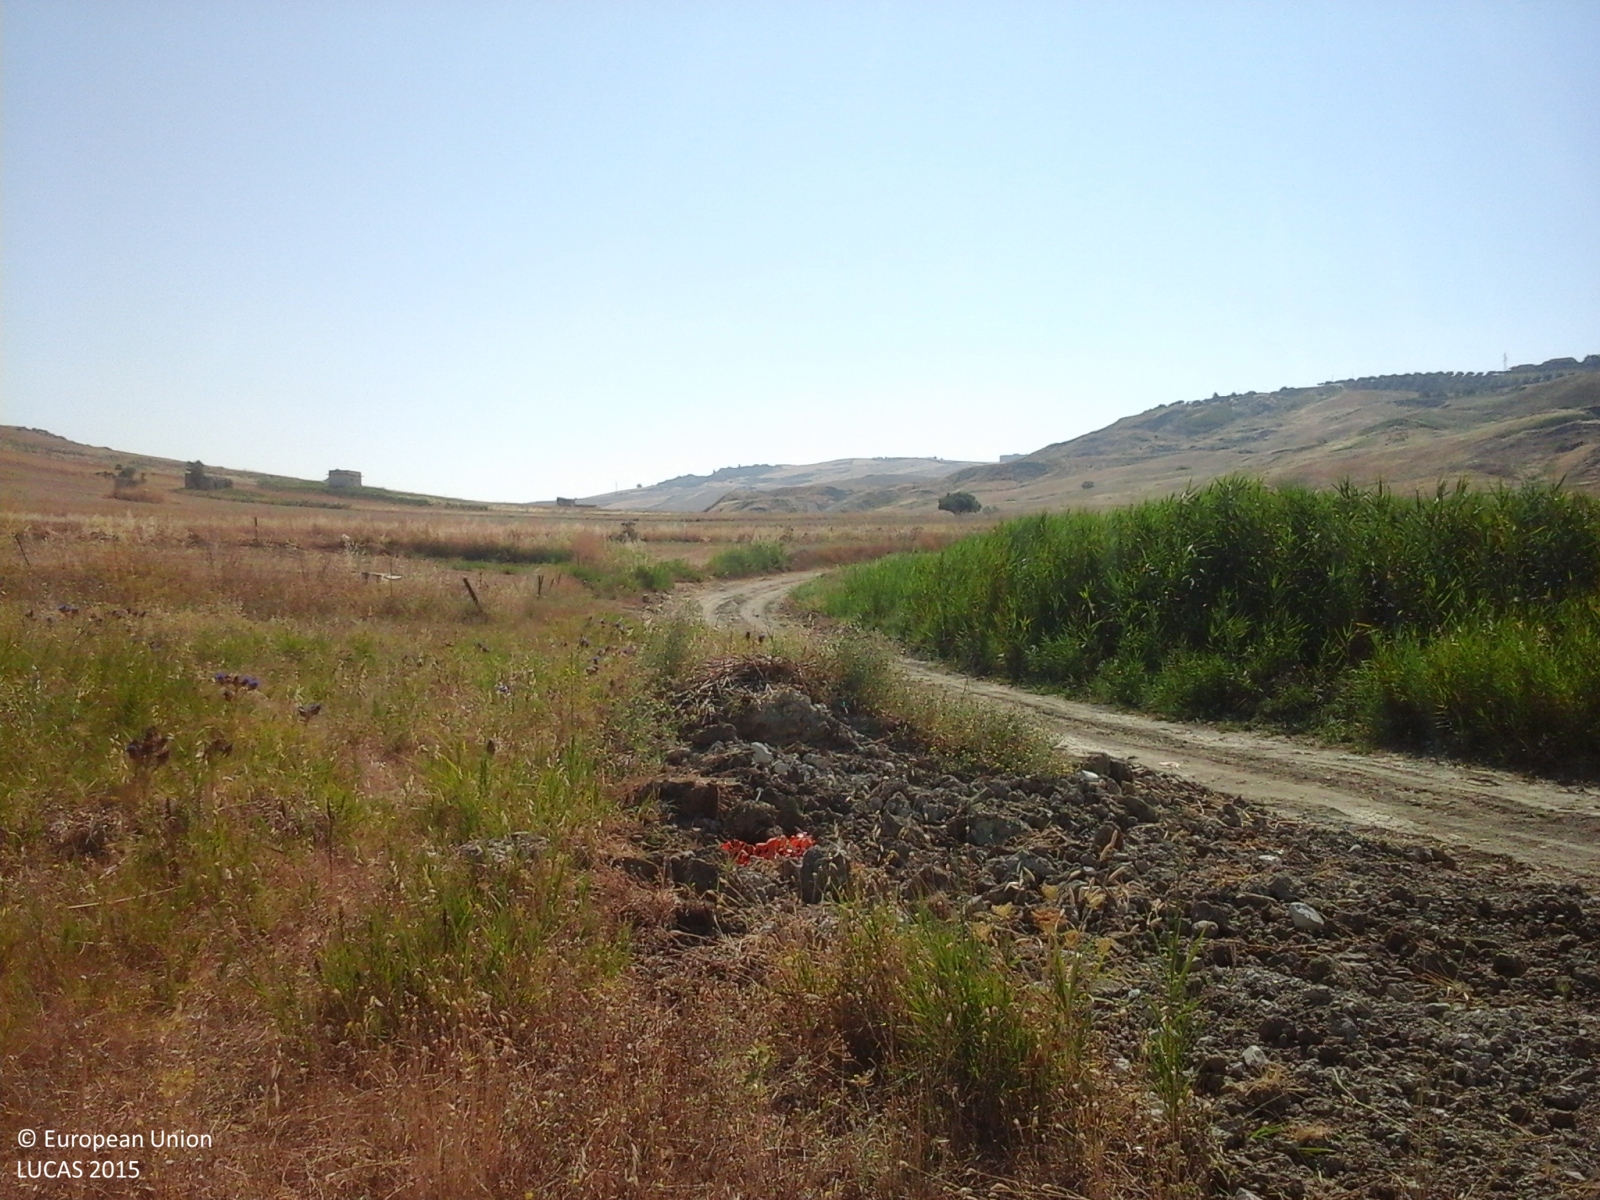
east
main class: Grassland
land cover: Spontaneously vegetated surfaces
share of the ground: > 75 %
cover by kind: herbaceous plants 100 %
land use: Fallow land
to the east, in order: Spontaneously vegetated surfaces; Ditches and canals; Other bare soil; Grass margins; Fences; Lucerne; Grass margins; Fences; Grass margins; Lucerne; Spontaneously vegetated surfaces; Other bare soil; Spontaneously vegetated surfaces; Artificial constructions in urban areas
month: July
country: IT
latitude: 37.3533
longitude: 13.5736
